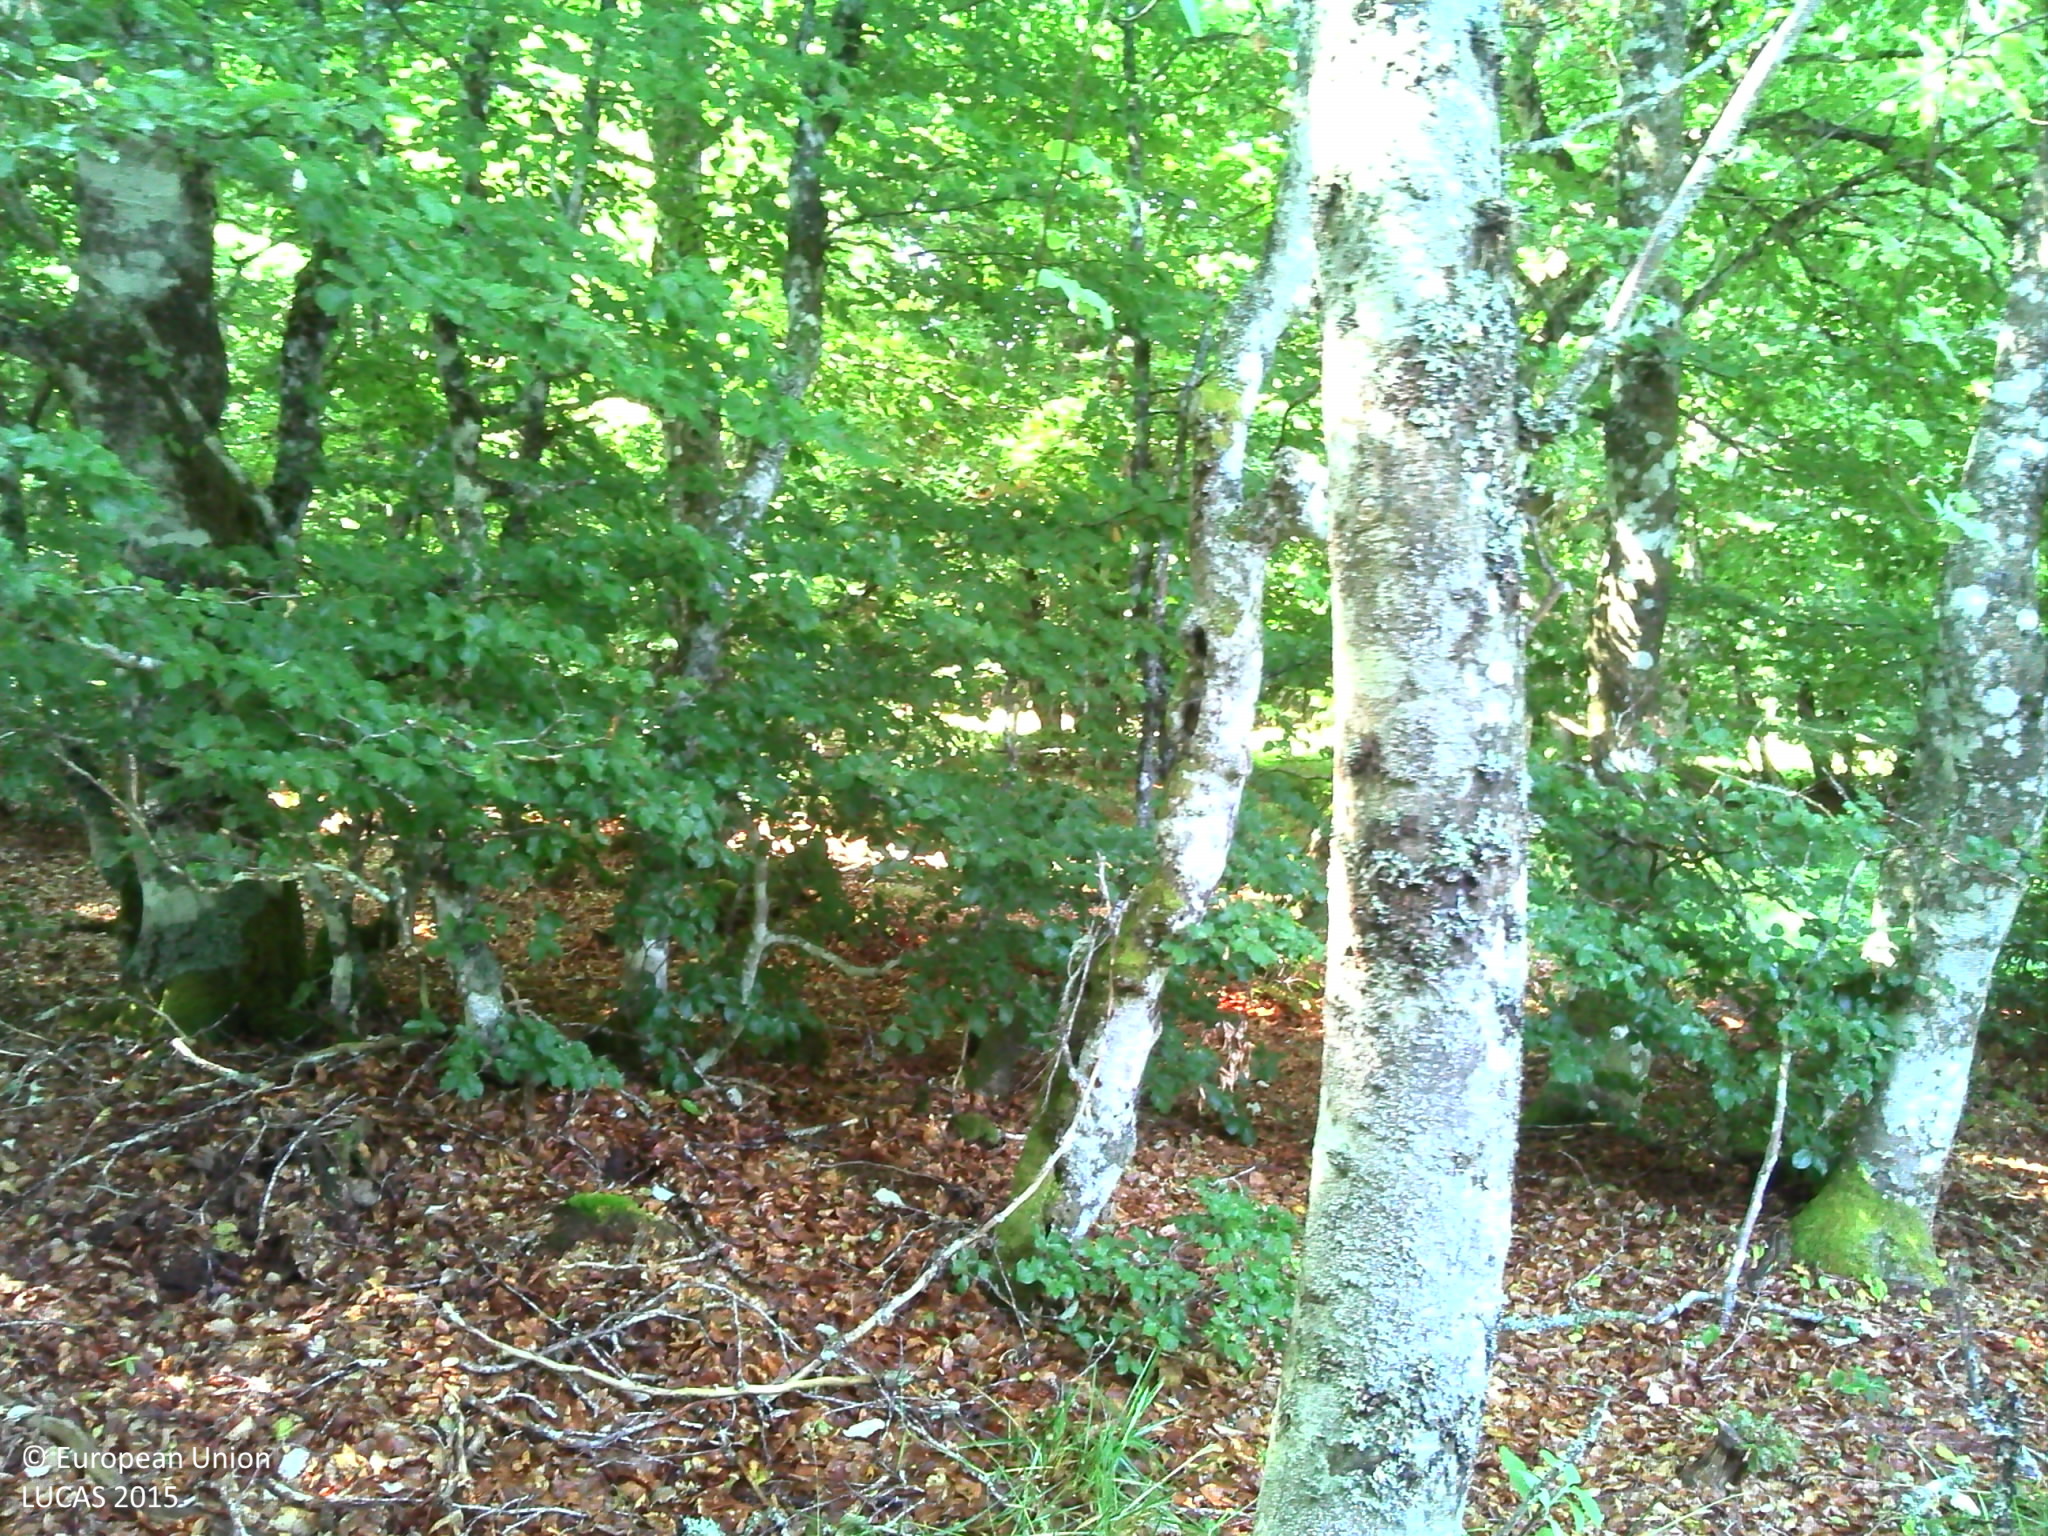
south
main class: Woodland
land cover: Spruce dominated mixed woodland
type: mountainous beech forest
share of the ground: > 75 %
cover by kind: broadleaved forest trees 55 %, coniferous forest trees 20 %, herbaceous plants 10 %, lichens and mosses 10 %, shrubs 5 %
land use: Forestry
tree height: > 5 m
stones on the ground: < 10 %
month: July
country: FR
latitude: 44.6880
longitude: 2.9246
